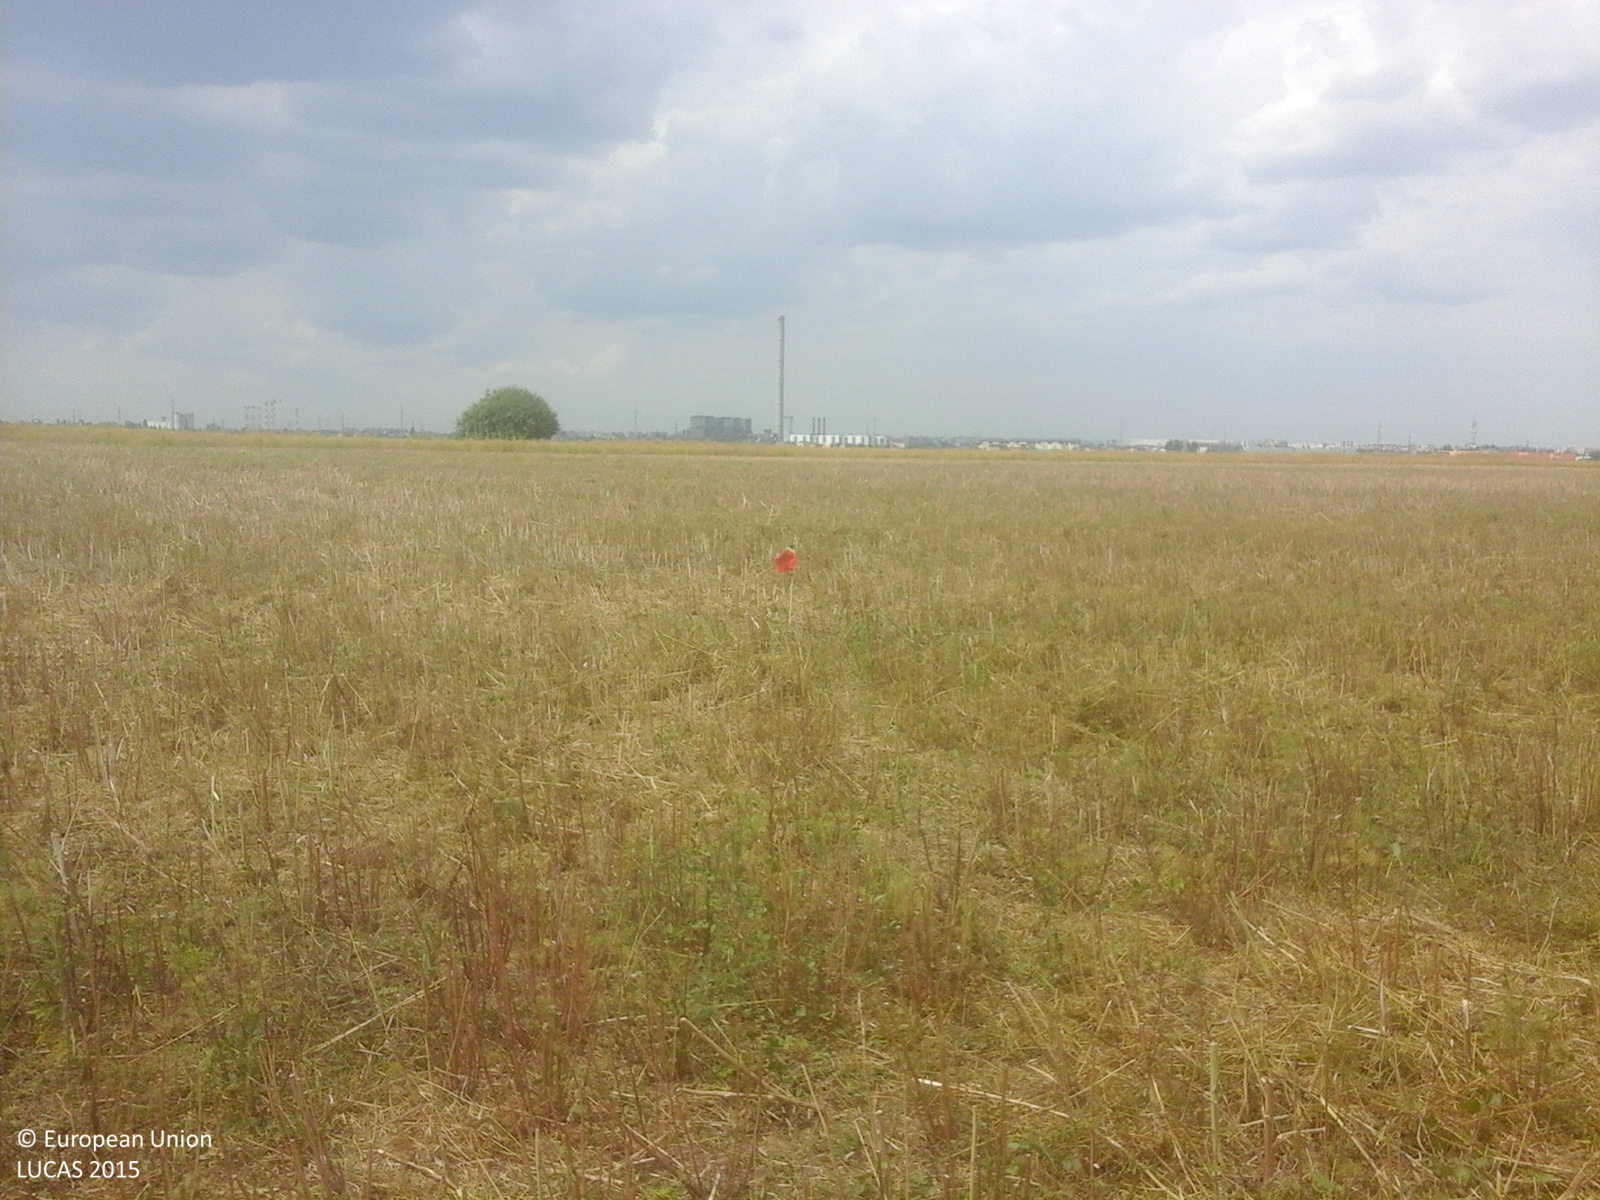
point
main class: Cropland
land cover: Other leguminous and mixtures for fodder
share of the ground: > 75 %
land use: Agriculture (excluding fallow land and kitchen gardens)
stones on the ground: < 10 %
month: June
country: RO
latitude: 44.3467
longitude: 26.1236
